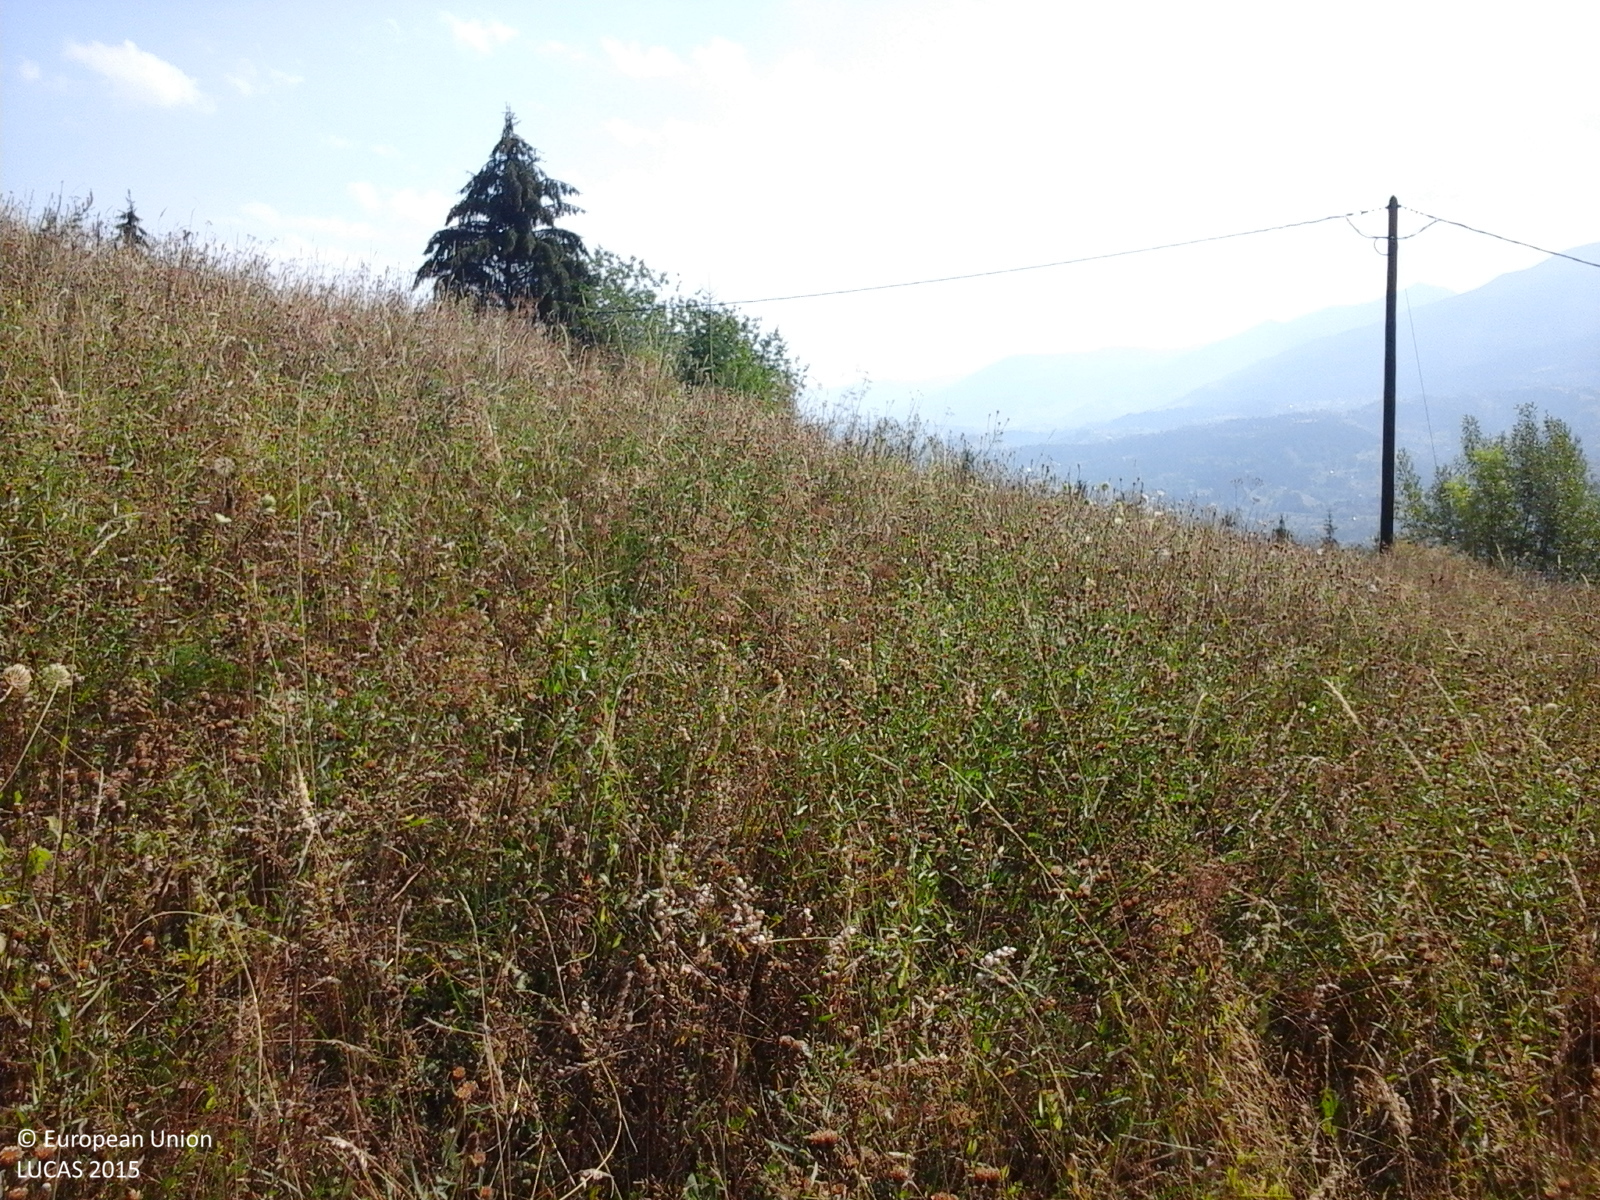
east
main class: Grassland
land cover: Grassland without tree/shrub cover
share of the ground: > 75 %
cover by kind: herbaceous plants 100 %
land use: Agriculture (excluding fallow land and kitchen gardens)
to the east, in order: Grassland without tree/shrub cover; Electric lines; Grassland without tree/shrub cover; Tracks; Grassland with sparse tree/shrub cover; Broadleaved woodland; Grassland with sparse tree/shrub cover; Other fresh vegetables; Broadleaved woodland; Grassland with sparse tree/shrub cover; Tracks; Grassland with sparse tree/shrub cover; Spruce dominated coniferous woodland
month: September
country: RO
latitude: 47.6691
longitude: 24.5726
